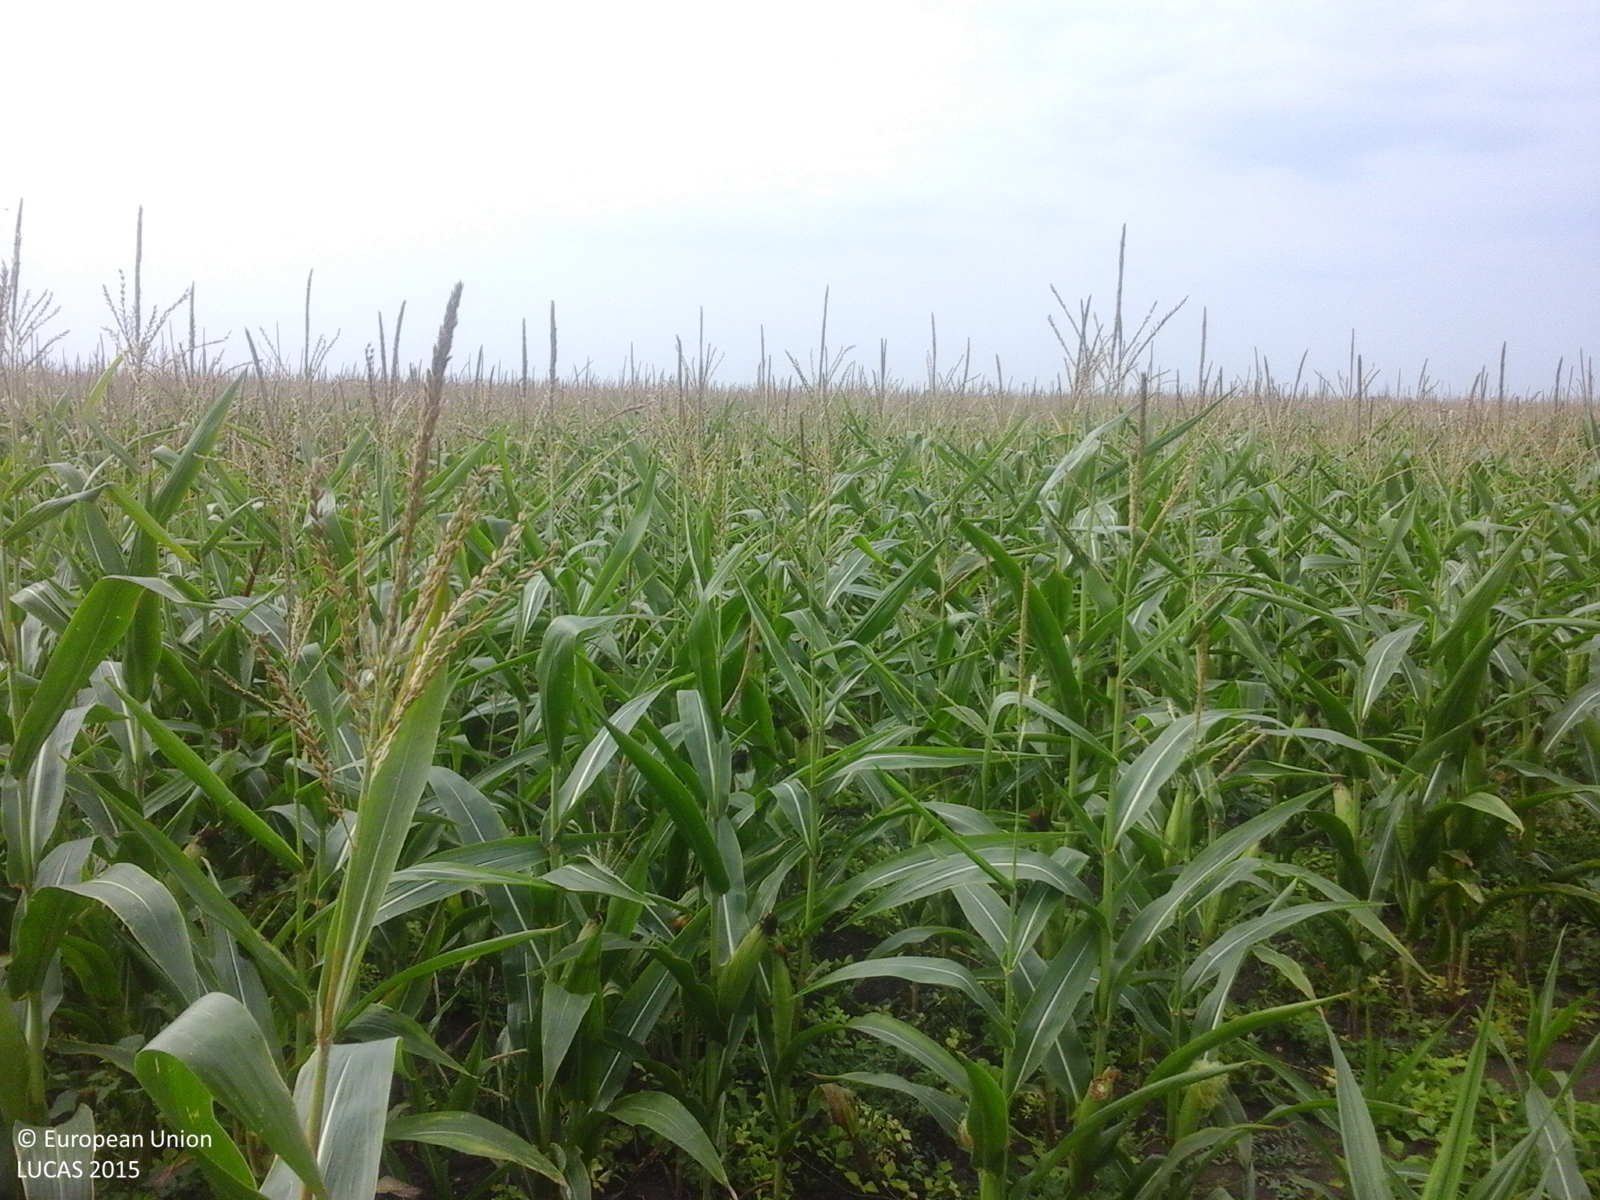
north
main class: Cropland
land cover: Maize
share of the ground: > 75 %
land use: Agriculture (excluding fallow land and kitchen gardens)
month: August
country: RO
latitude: 46.3775
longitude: 21.3857
